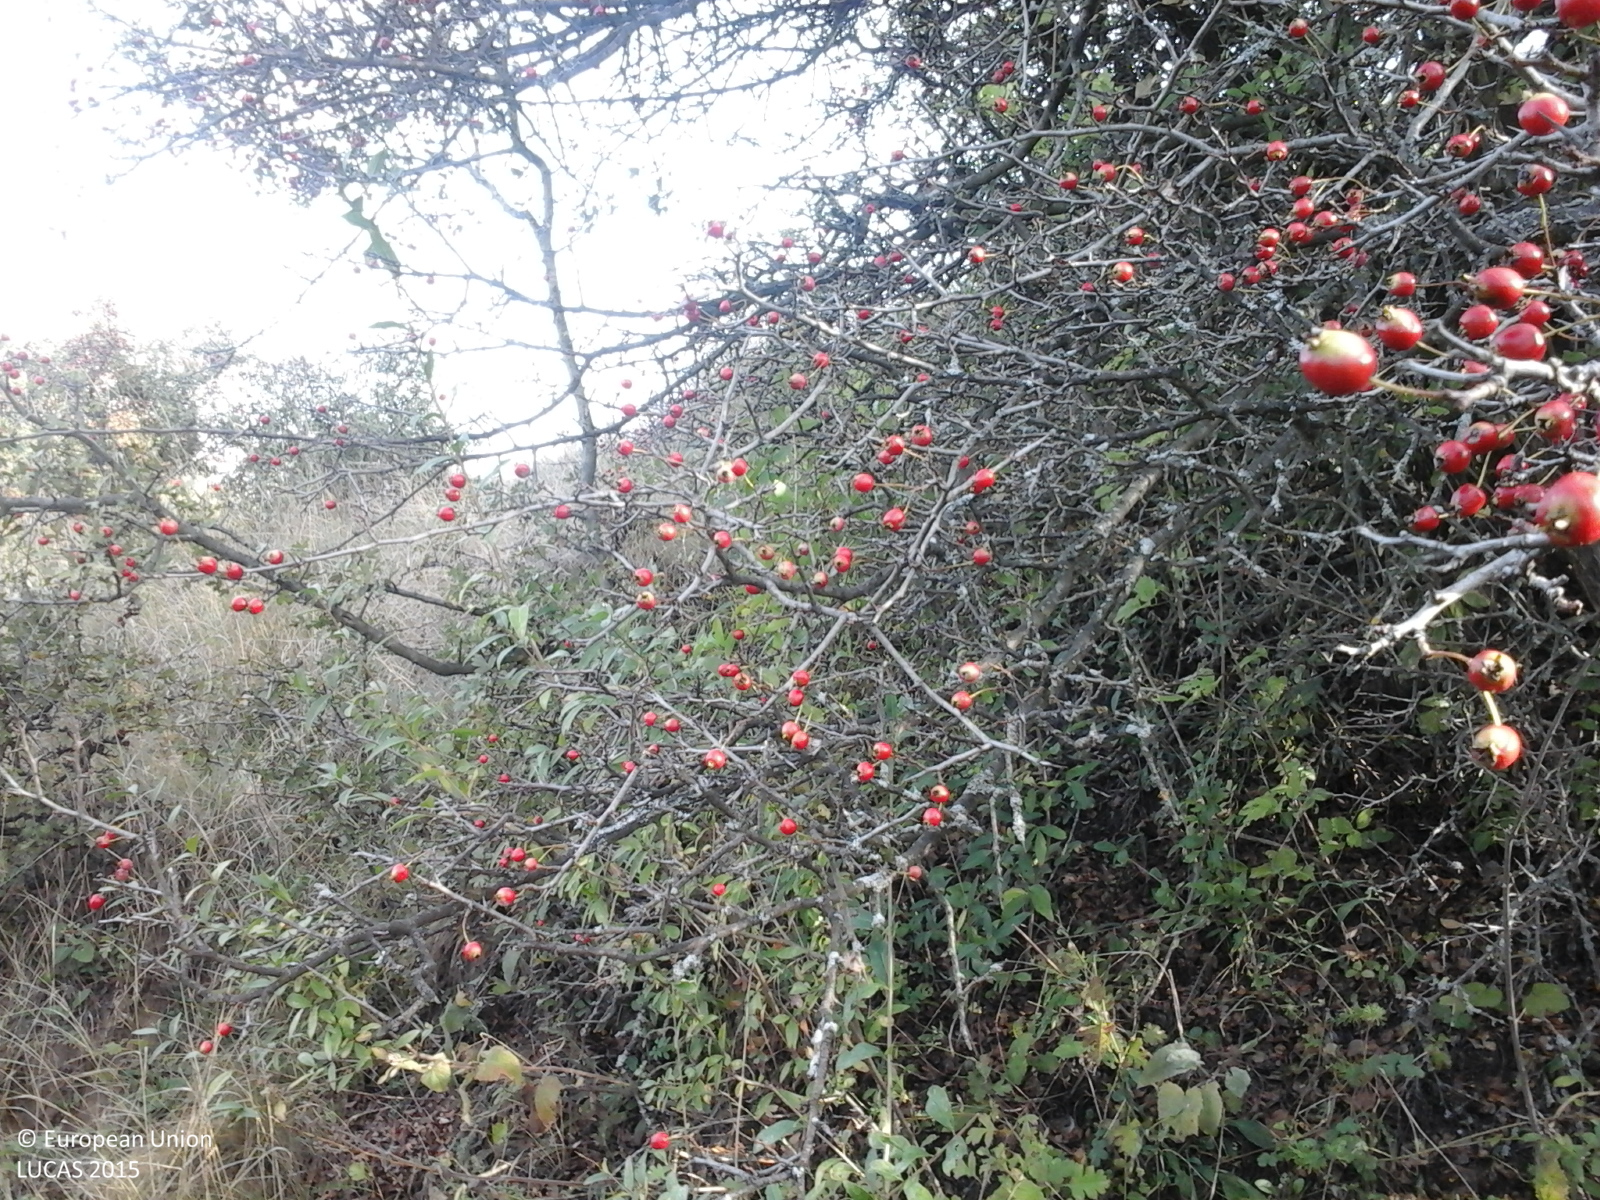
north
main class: Shrubland
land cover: Shrubland with sparse tree cover
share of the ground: > 75 %
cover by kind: herbaceous plants 85 %, shrubs 10 %, broadleaved forest trees 5 %
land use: Agriculture (excluding fallow land and kitchen gardens)
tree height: > 5 m
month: September
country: RO
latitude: 46.8593
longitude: 23.3547
